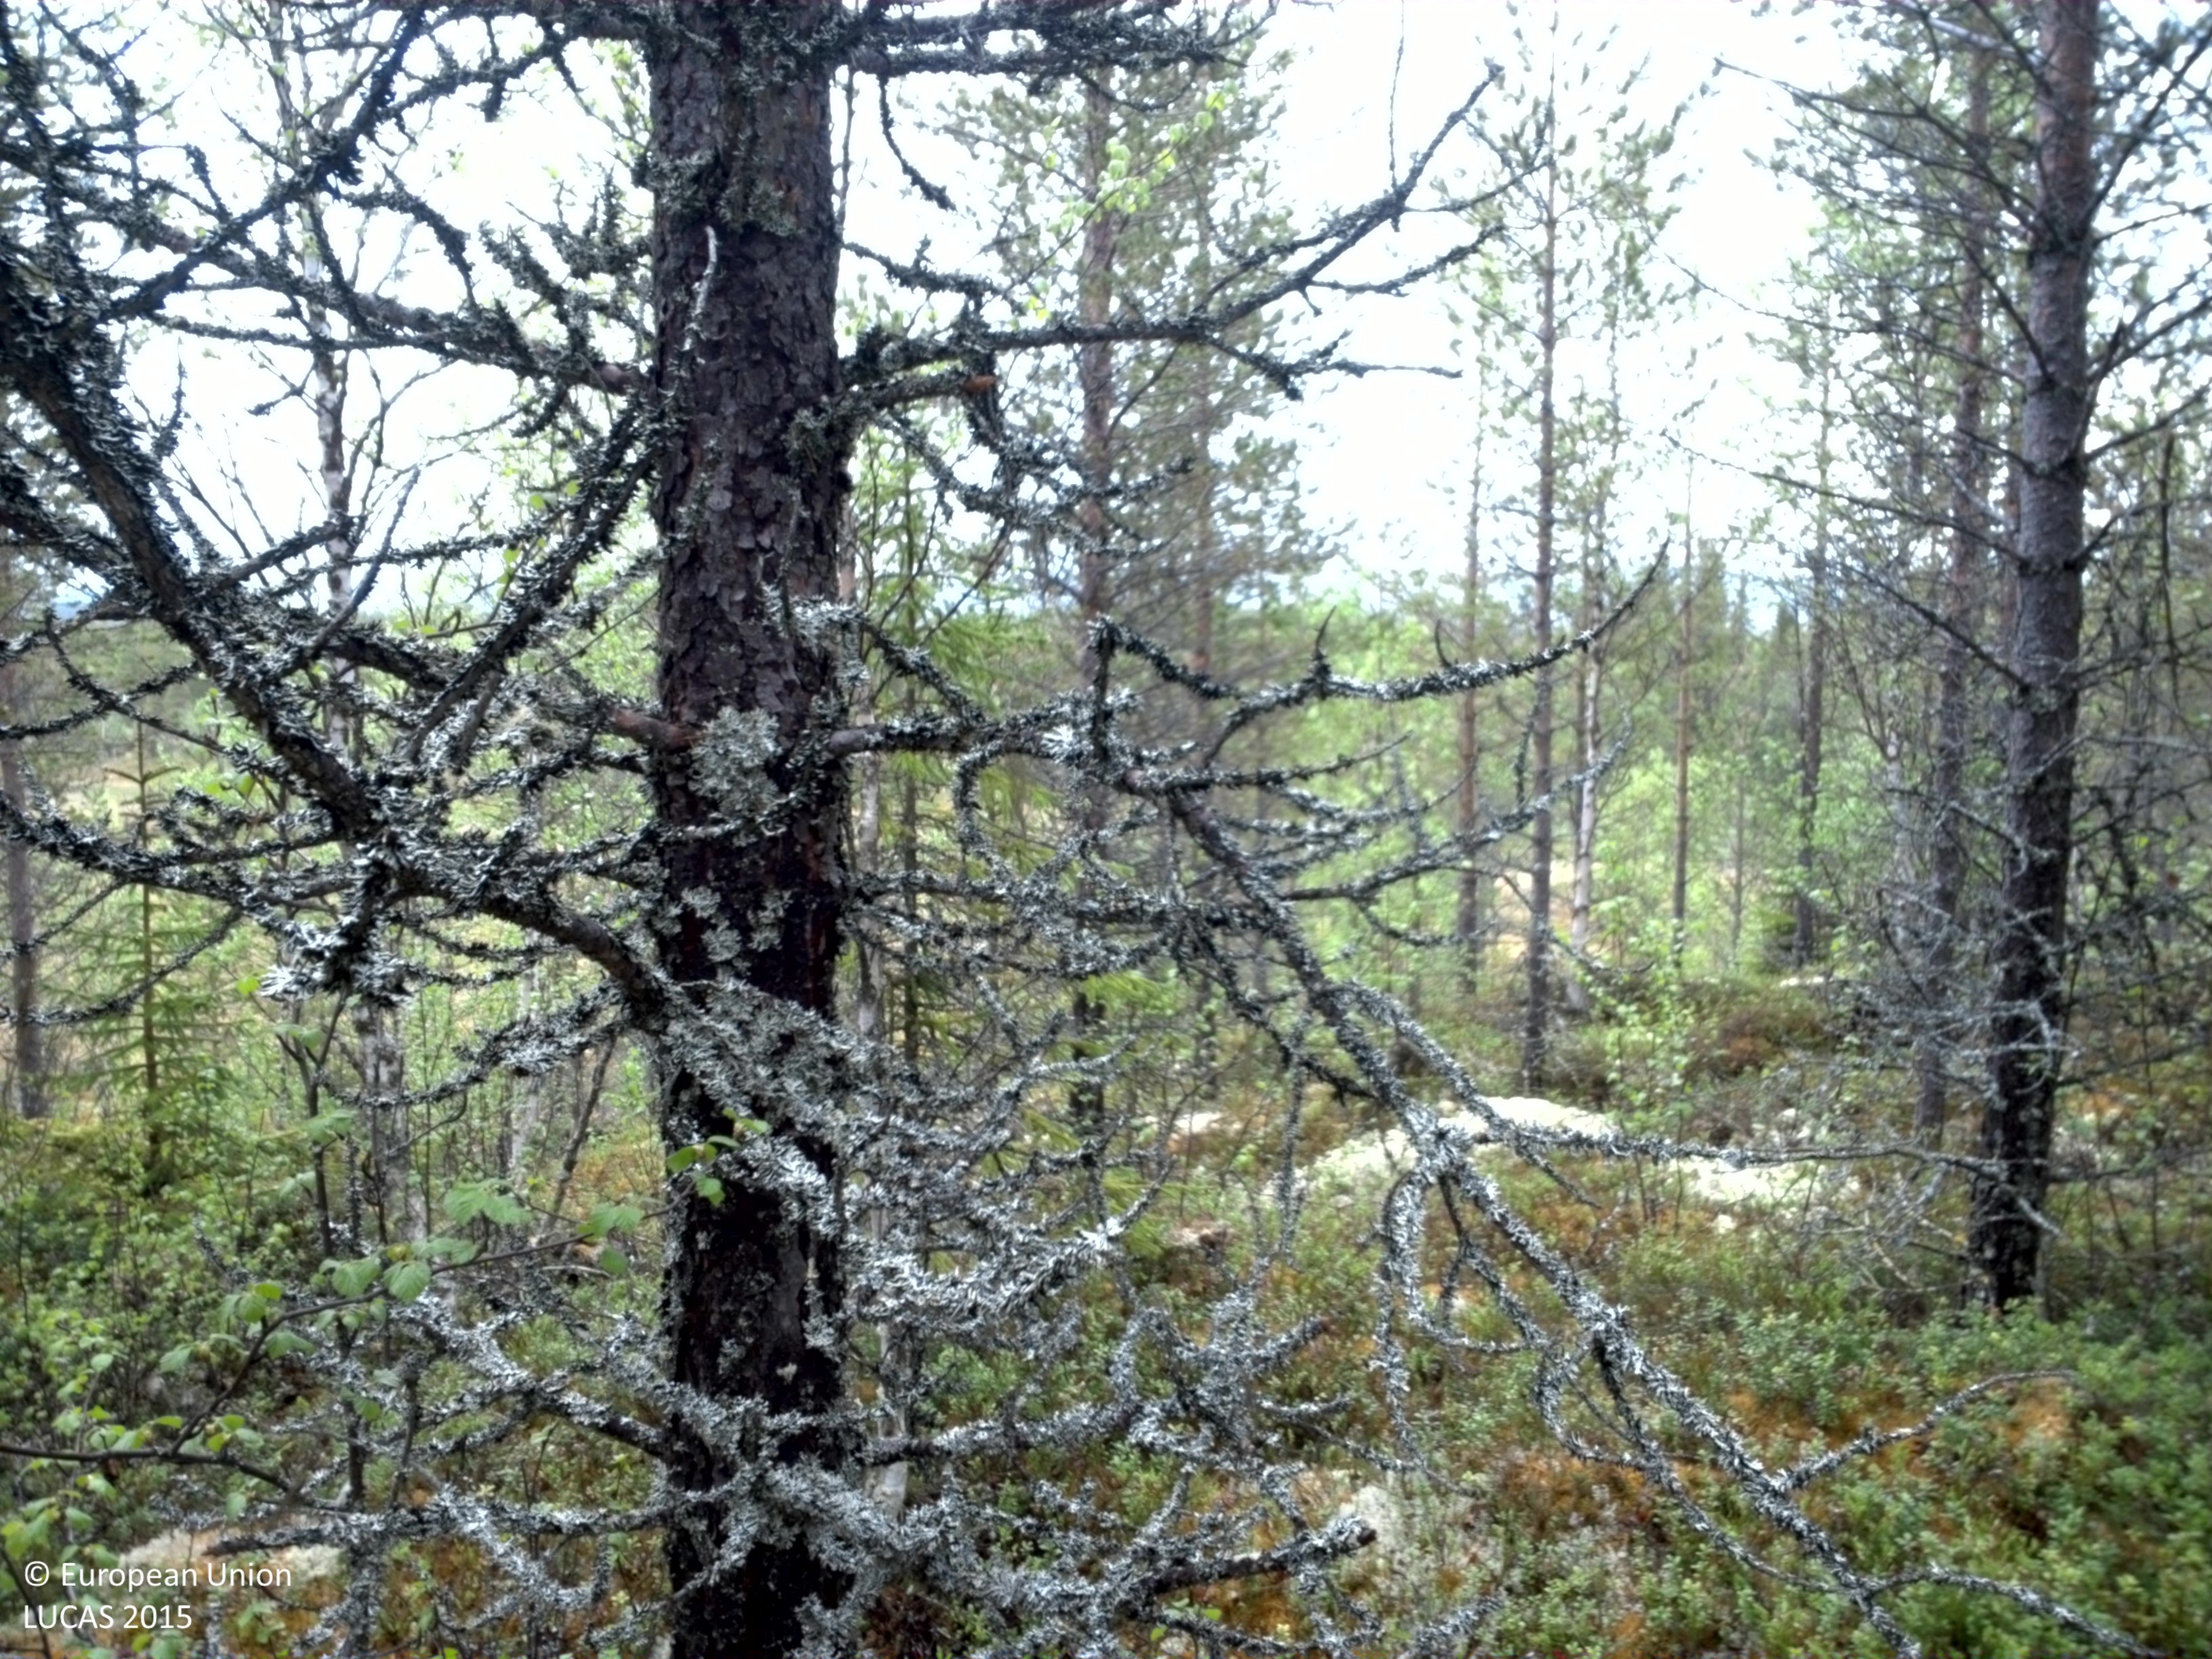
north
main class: Woodland
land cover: Pine dominated mixed woodland
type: boreal forest
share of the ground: 50 - 75 %
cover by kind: coniferous forest trees 40 %, shrubs 35 %, broadleaved forest trees 15 %, lichens and mosses 10 %
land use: Forestry
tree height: > 5 m
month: June
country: SE
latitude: 62.0640
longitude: 13.6018
